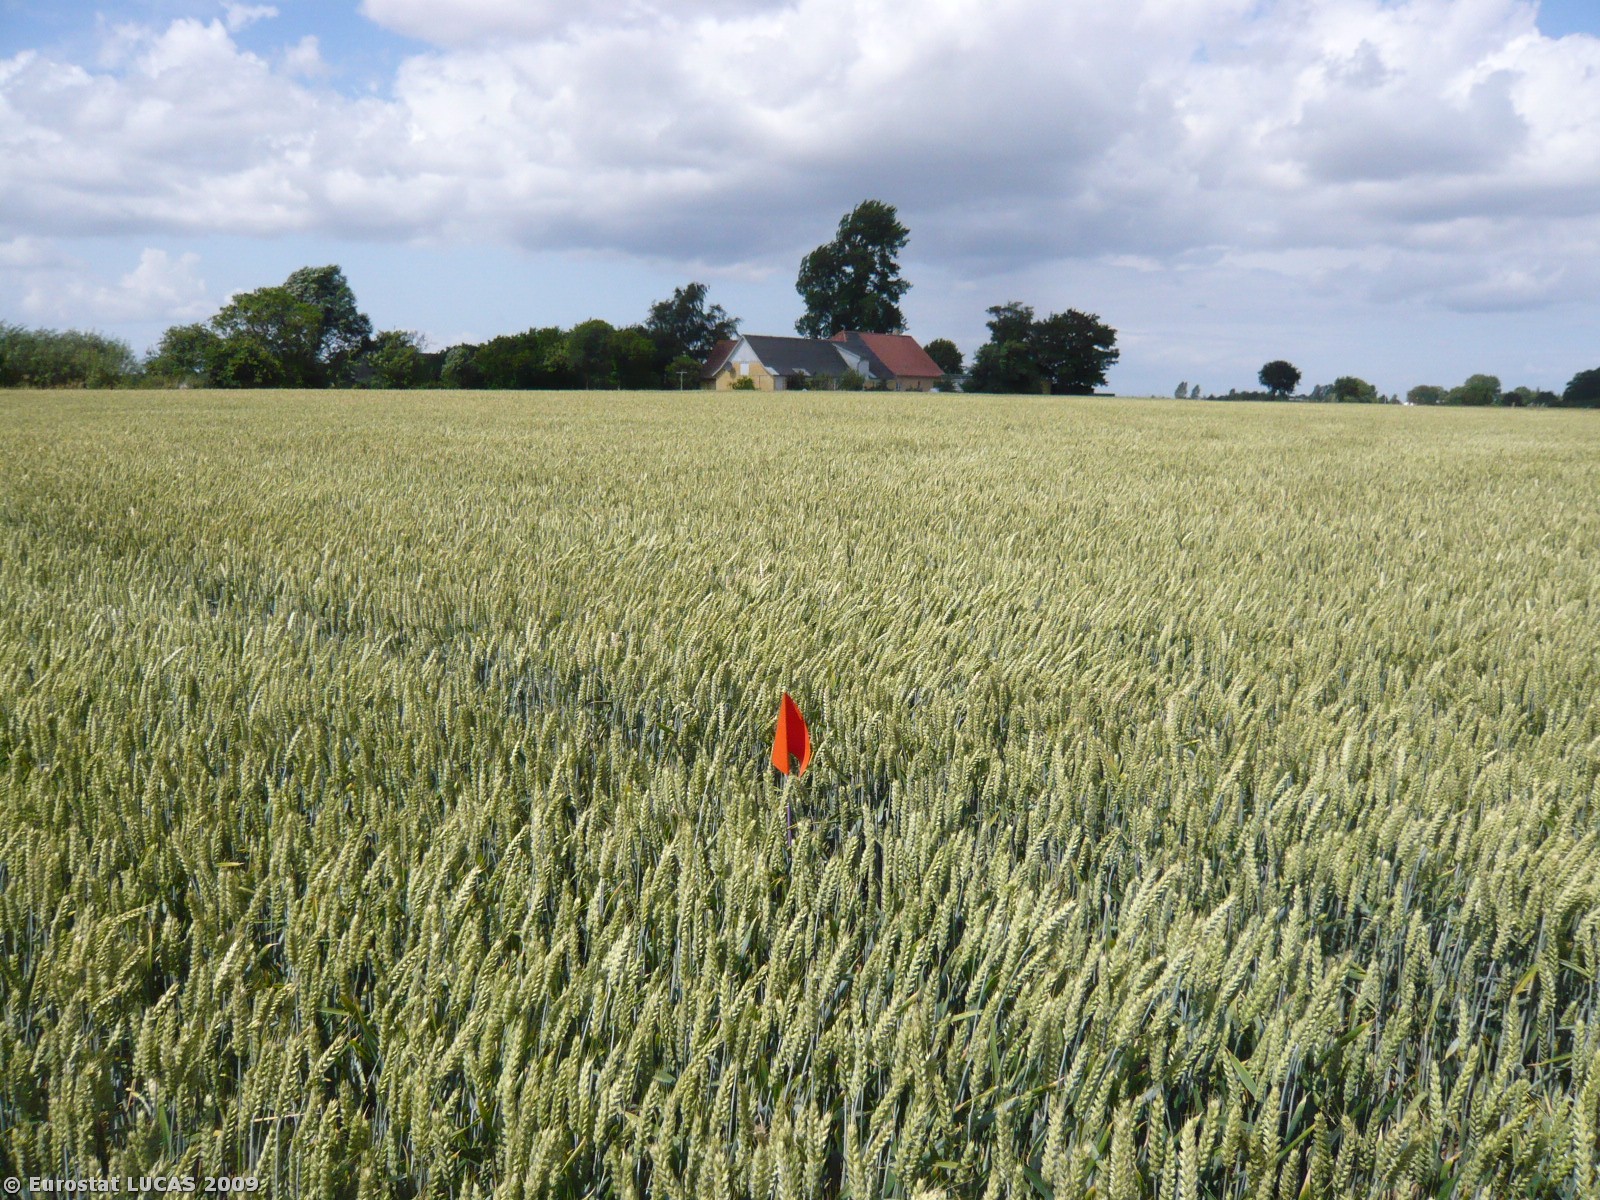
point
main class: Cropland
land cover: Common wheat
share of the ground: > 75 %
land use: Agriculture (excluding fallow land and kitchen gardens)
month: July
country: DK
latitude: 55.4132
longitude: 10.6470
